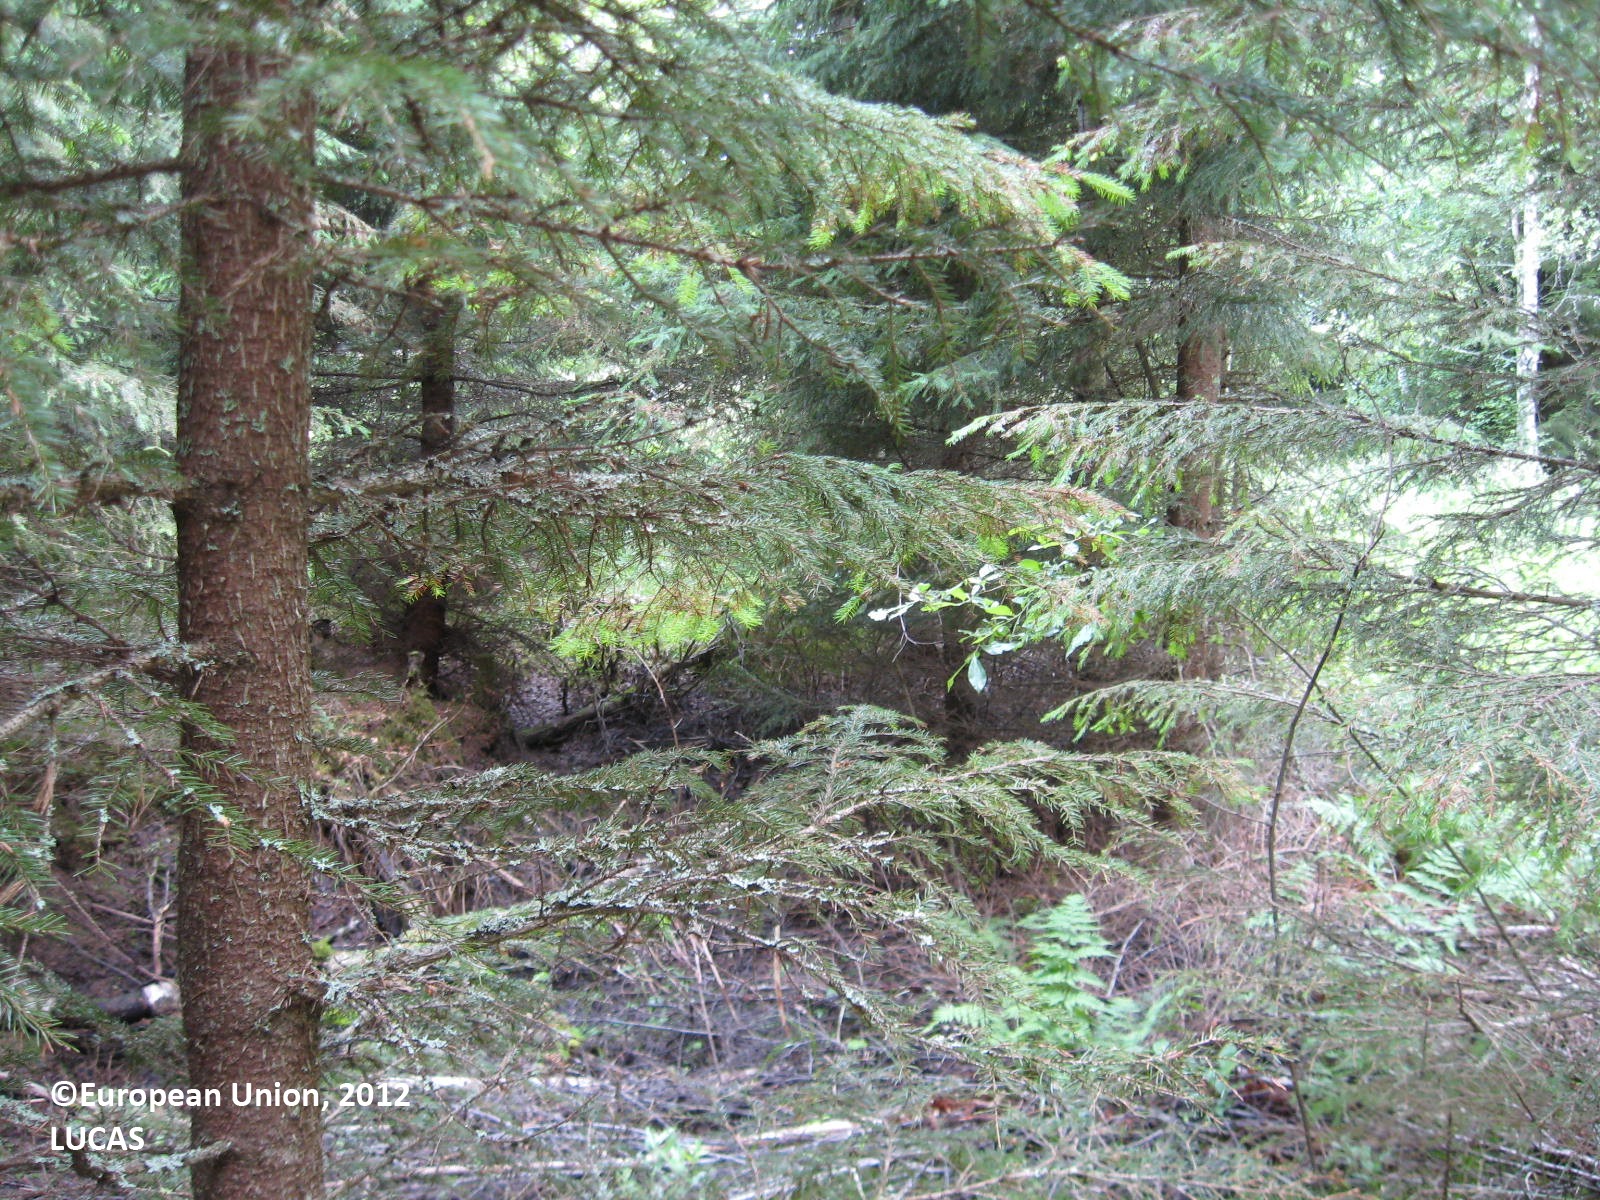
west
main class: Woodland
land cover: Spruce dominated mixed woodland
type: boreal forest
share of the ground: > 75 %
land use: Forestry
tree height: > 5 m
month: July
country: FI
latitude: 62.3529
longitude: 21.4997
